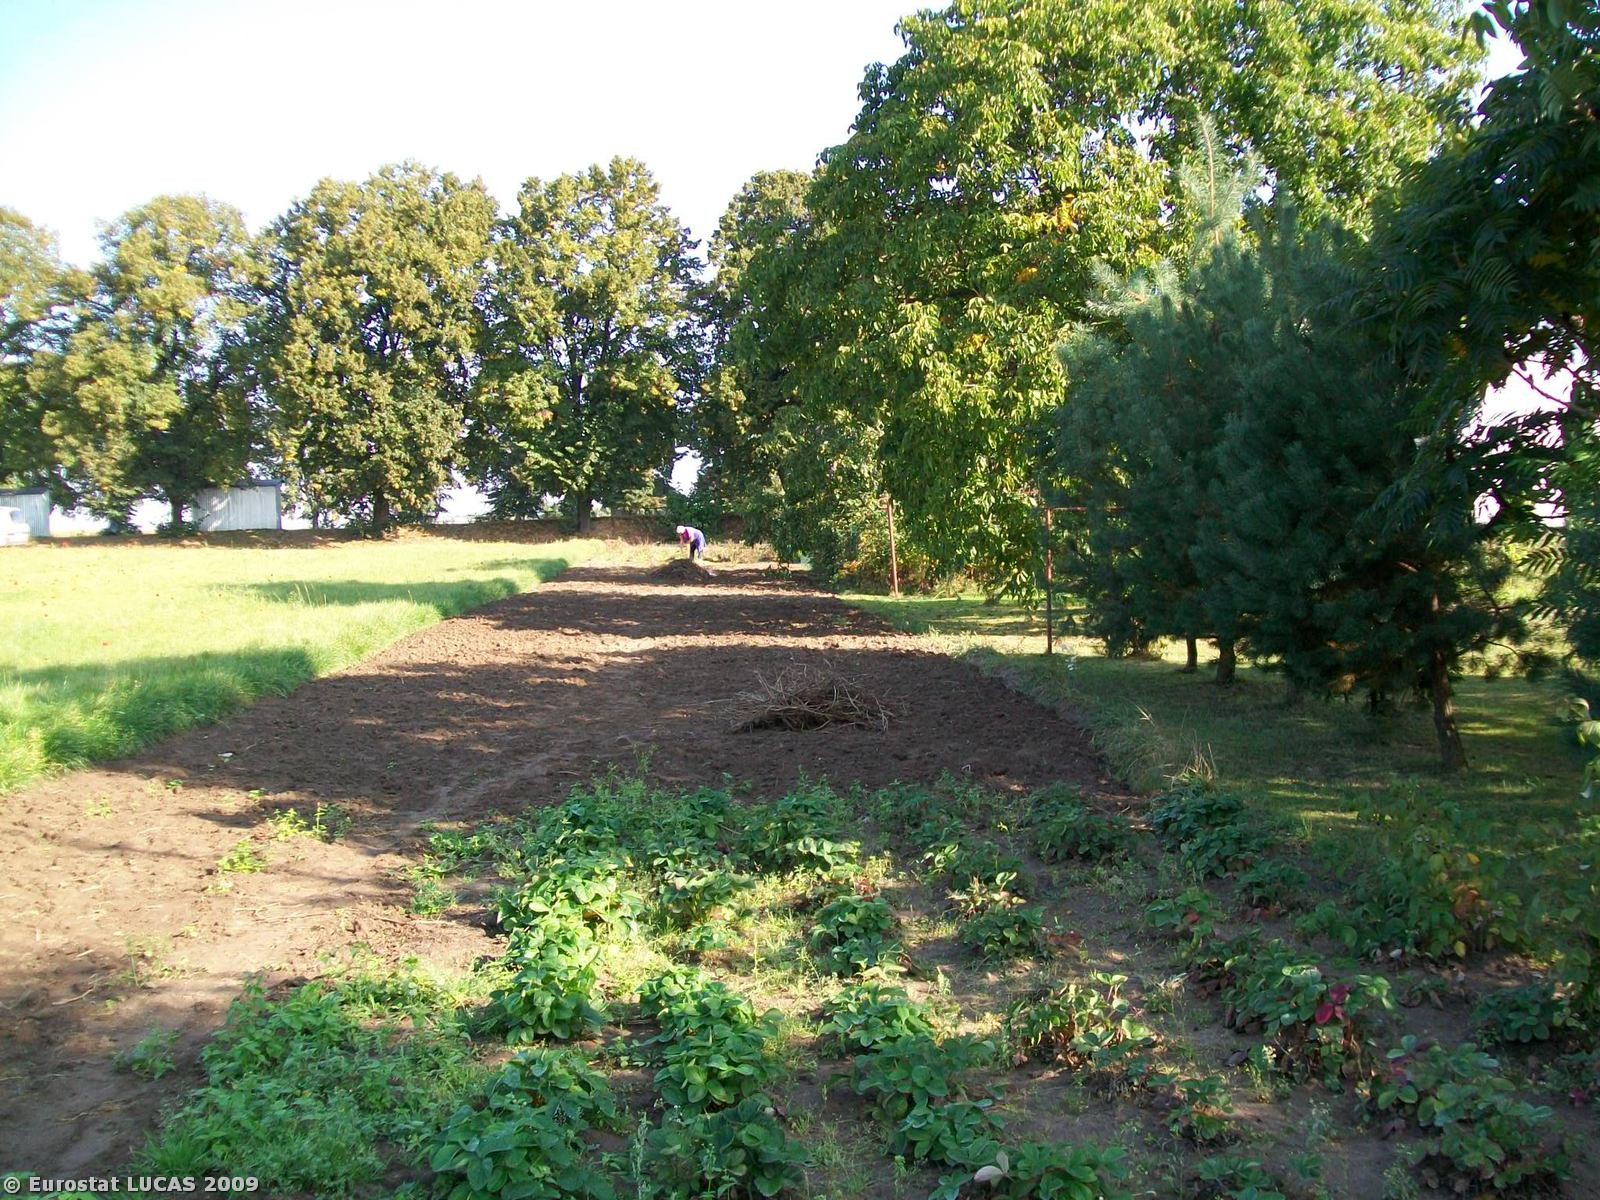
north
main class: Cropland
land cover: Strawberries
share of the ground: 25 - 50 %
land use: Kitchen garden
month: September
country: PL
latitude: 50.4614
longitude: 17.2094
